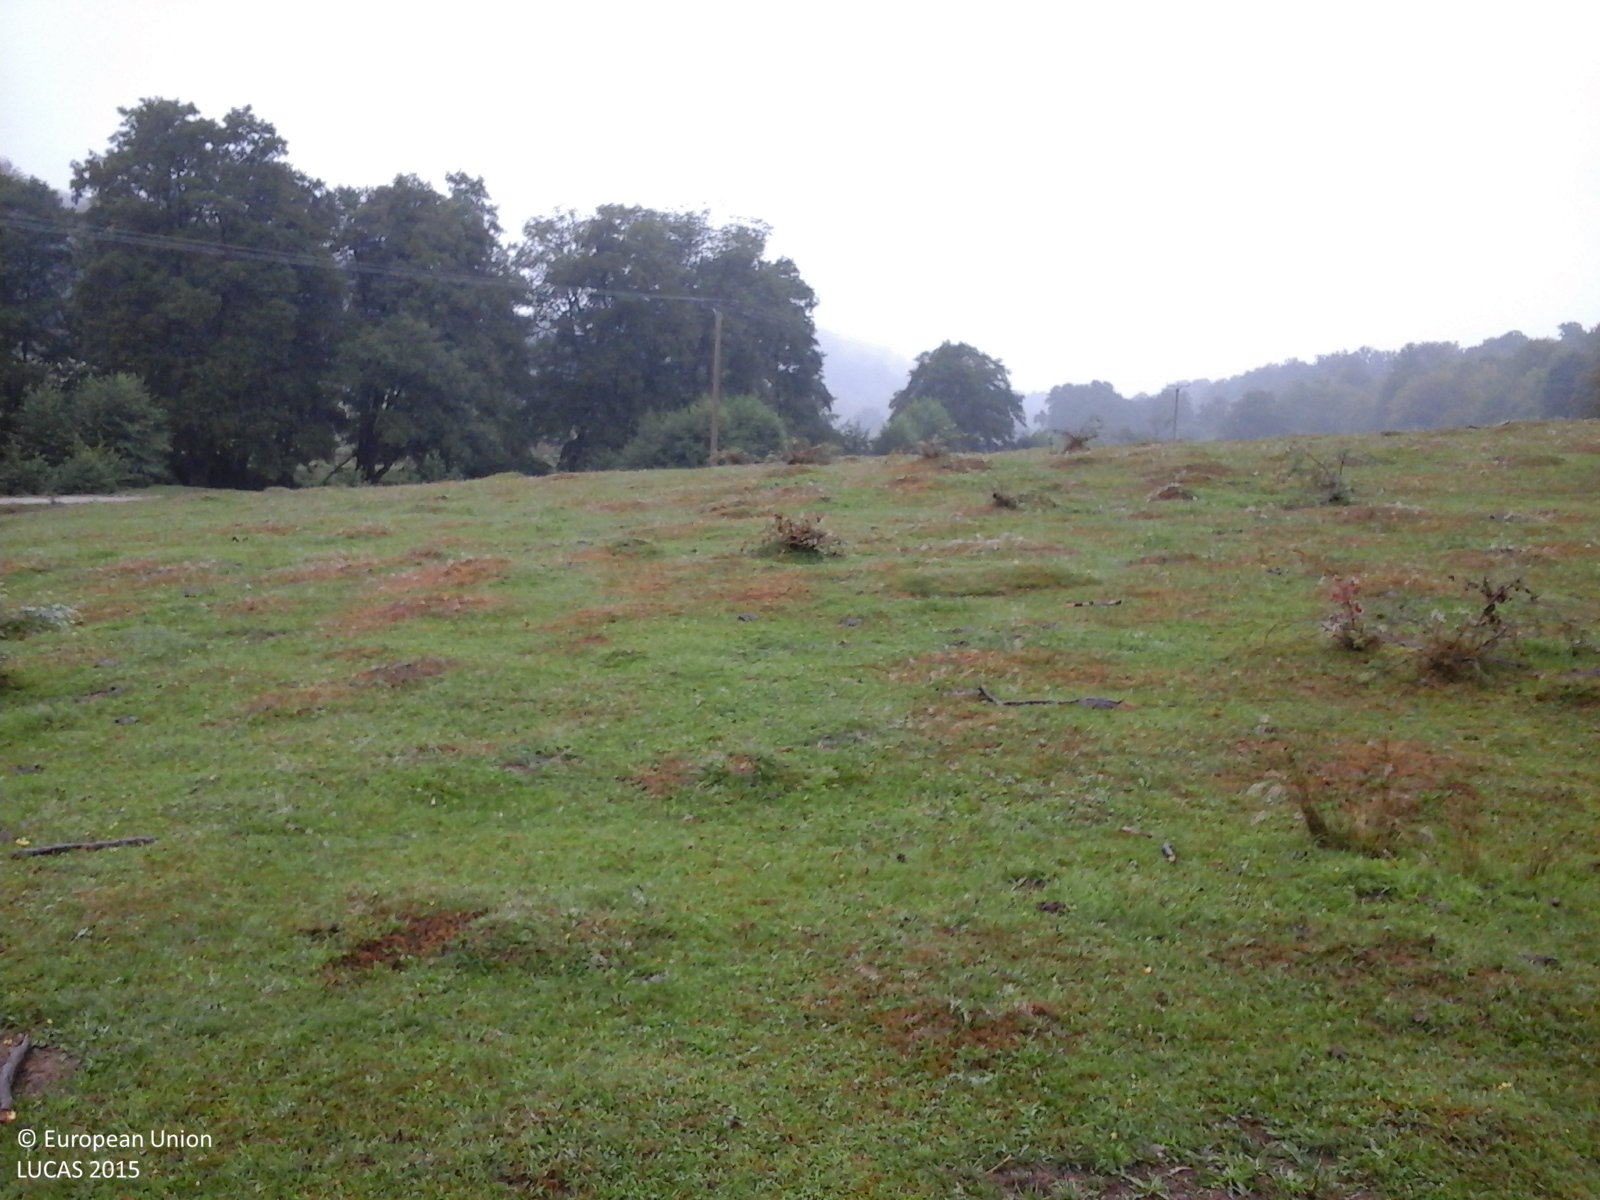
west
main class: Grassland
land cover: Grassland without tree/shrub cover
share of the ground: > 75 %
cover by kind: herbaceous plants 100 %
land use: Agriculture (excluding fallow land and kitchen gardens)
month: September
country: RO
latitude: 46.9481
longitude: 22.3093
